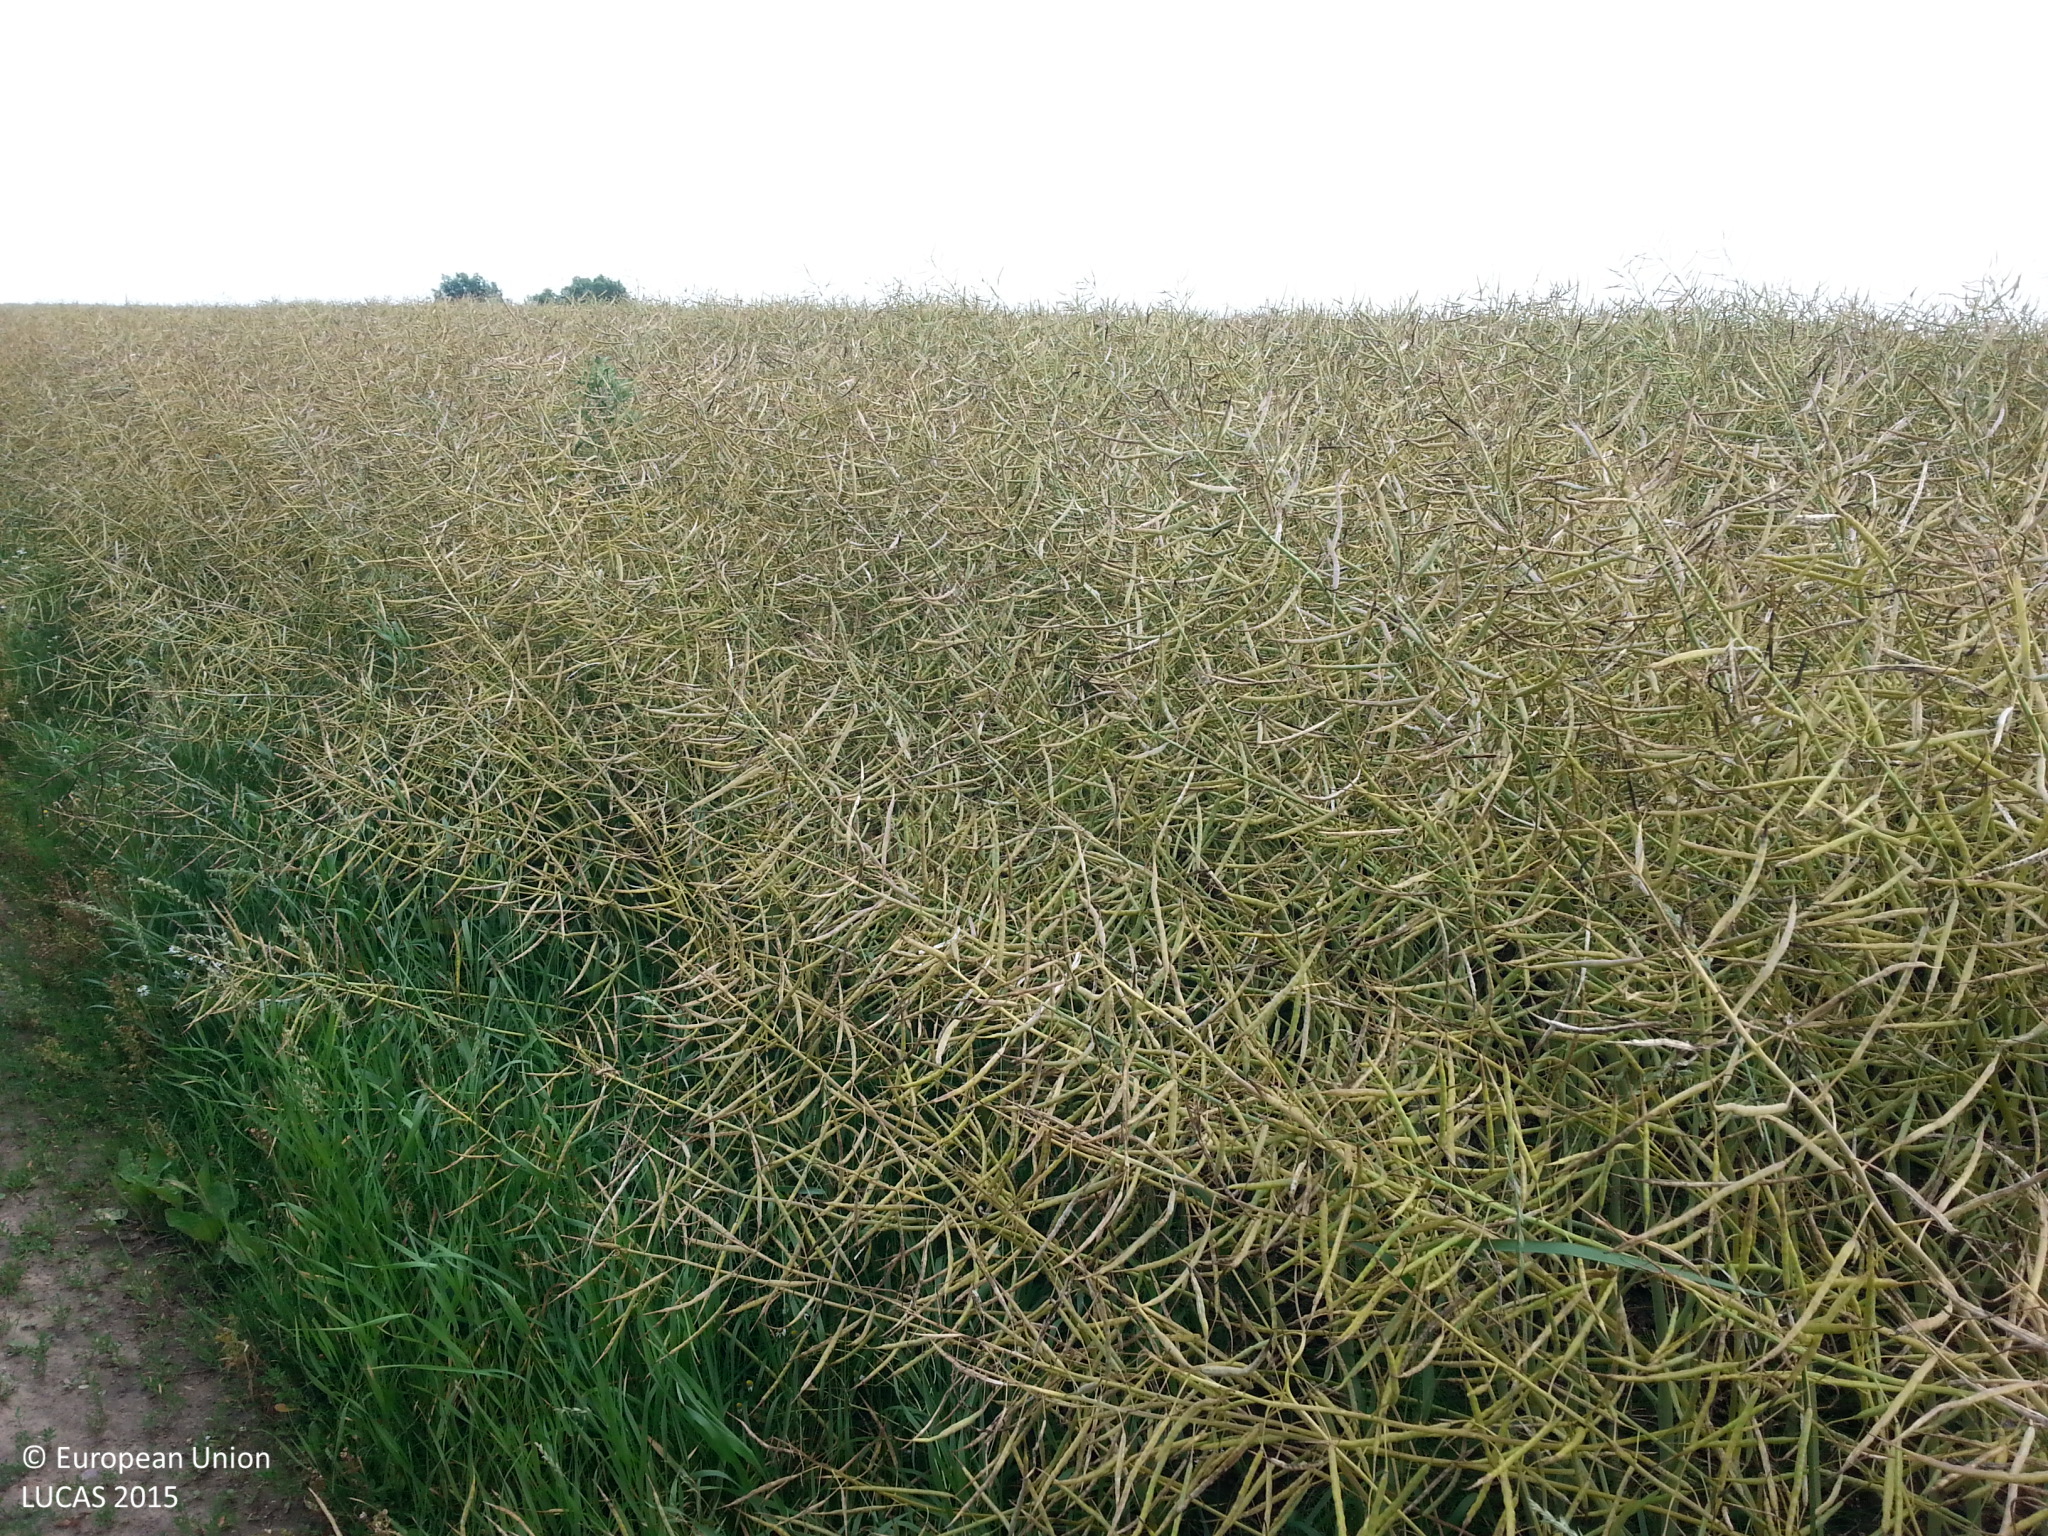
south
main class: Cropland
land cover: Rape and turnip rape
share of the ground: > 75 %
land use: Agriculture (excluding fallow land and kitchen gardens)
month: July
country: DE
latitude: 53.9717
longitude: 11.1428
